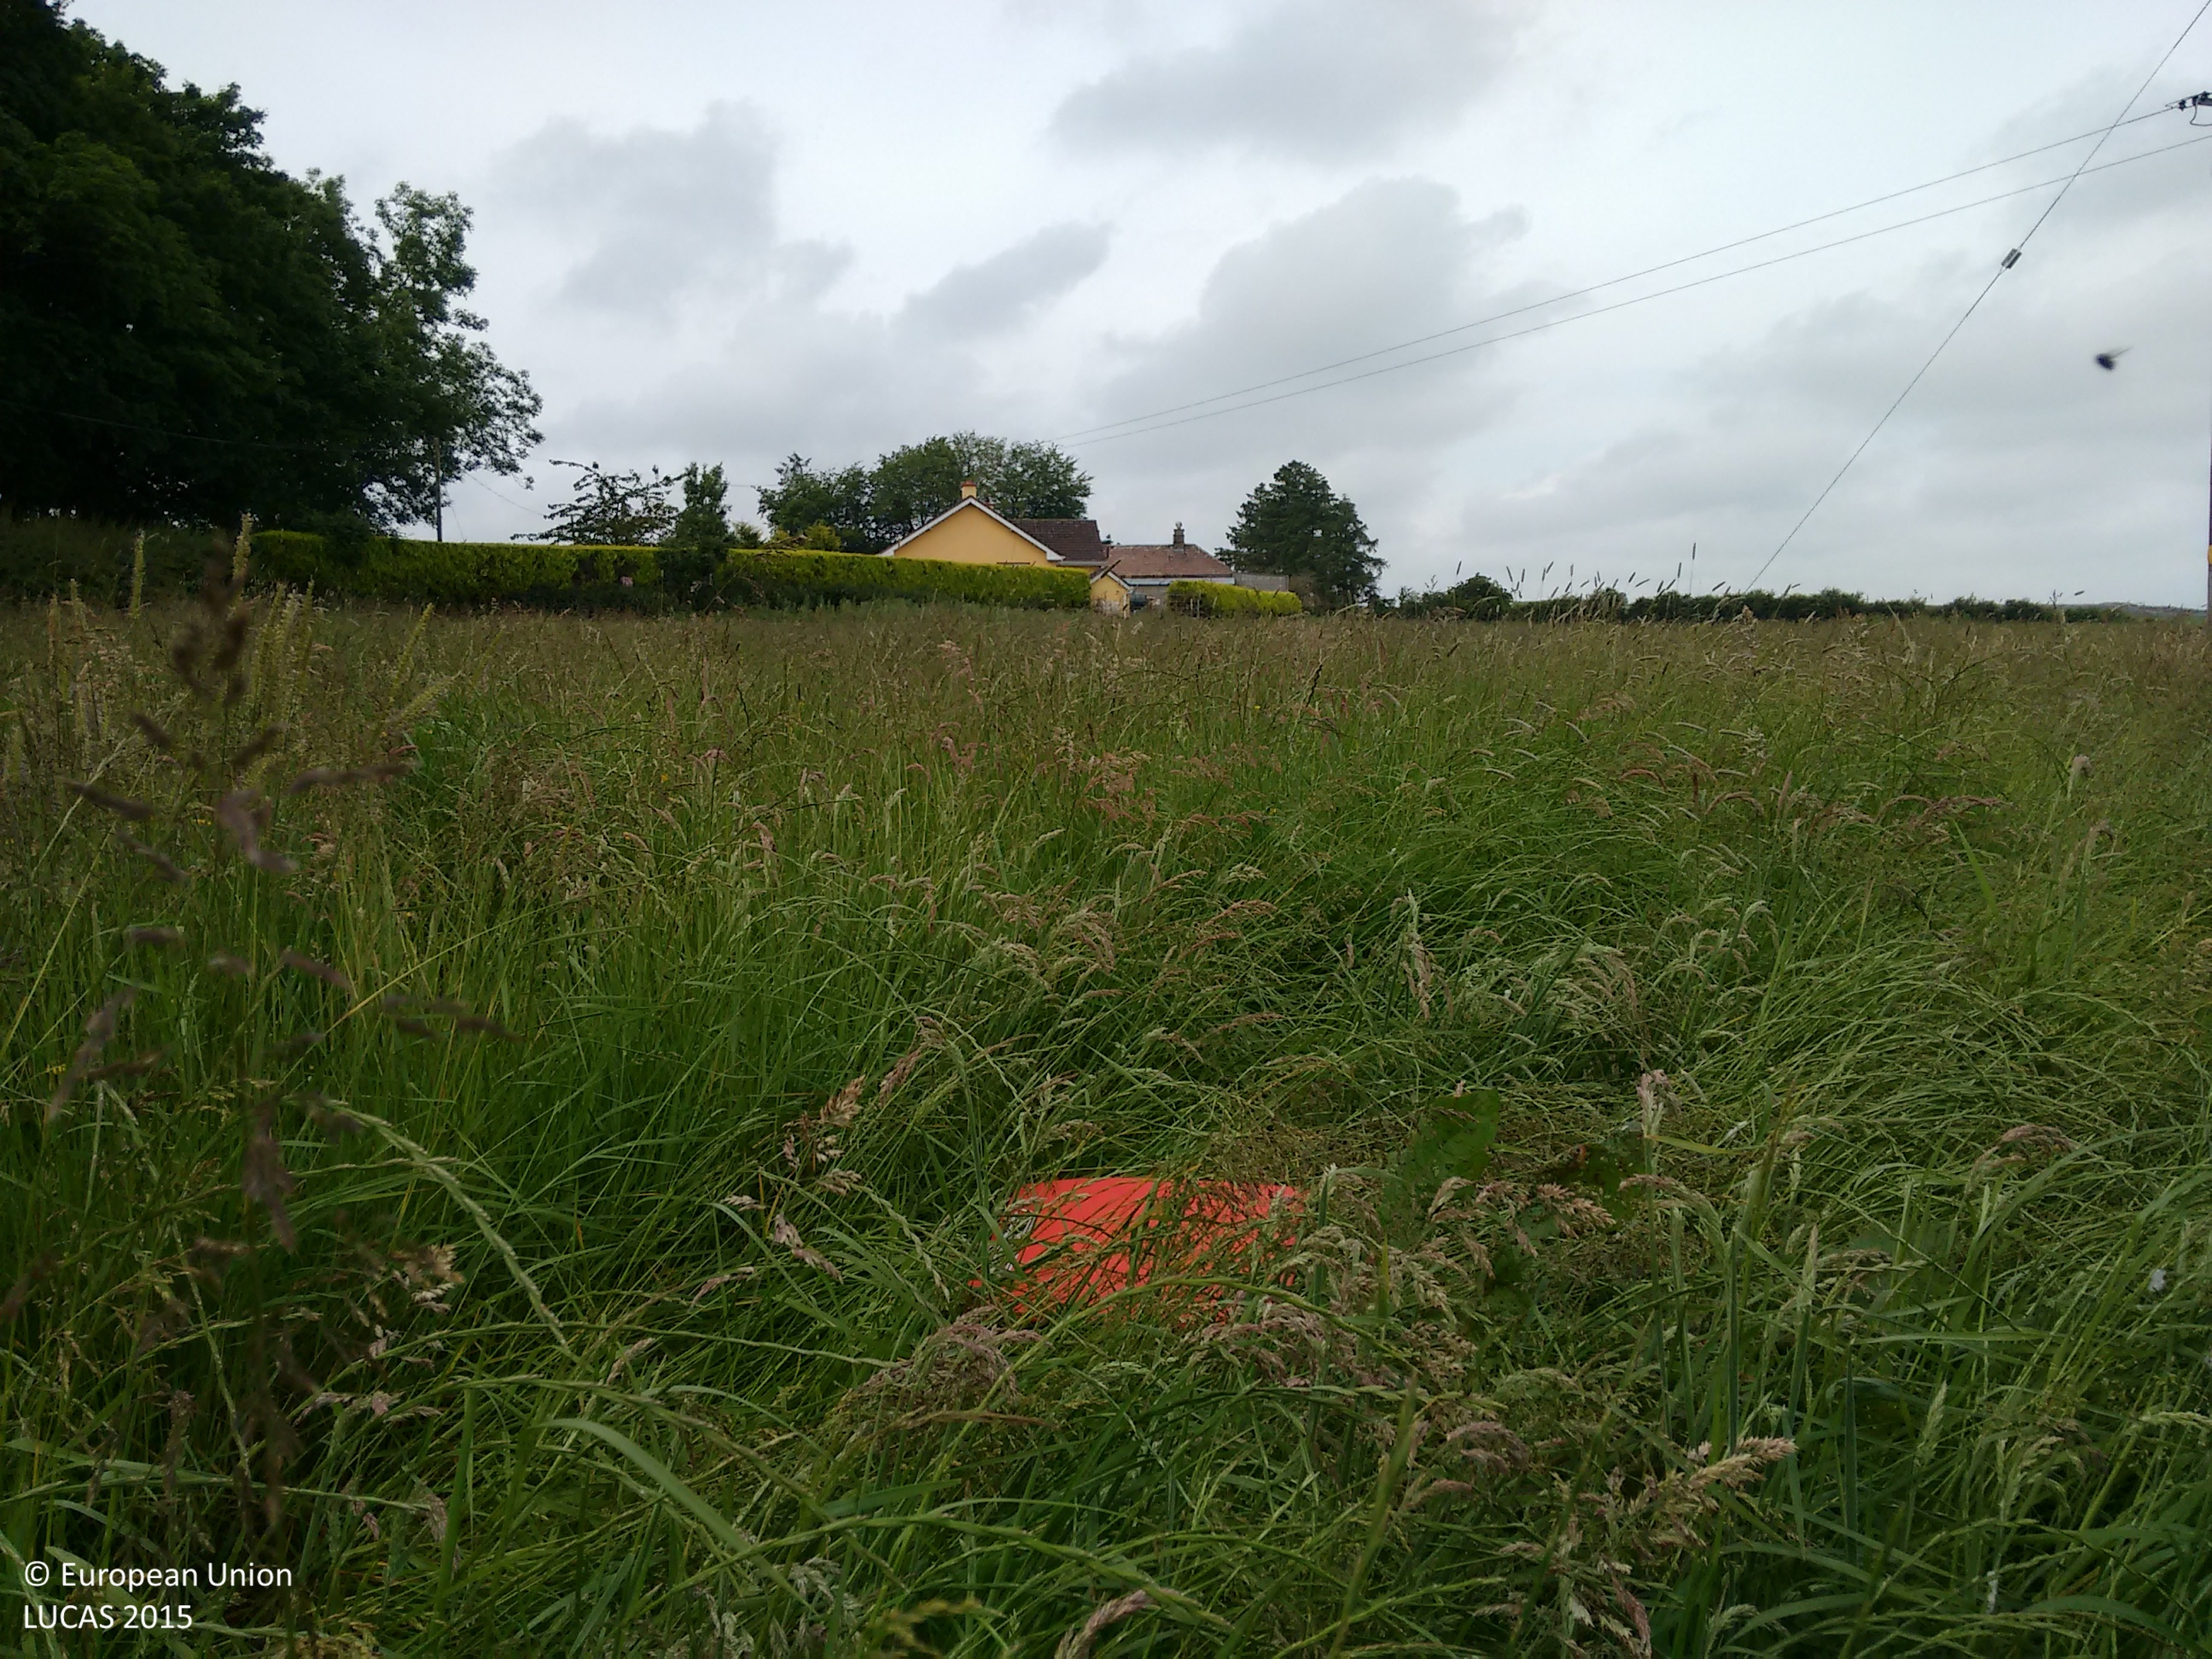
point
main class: Grassland
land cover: Grassland without tree/shrub cover
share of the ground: > 75 %
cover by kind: herbaceous plants 100 %
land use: Agriculture (excluding fallow land and kitchen gardens)
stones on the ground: < 10 %
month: July
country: IE
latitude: 53.7531
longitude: -7.1158
